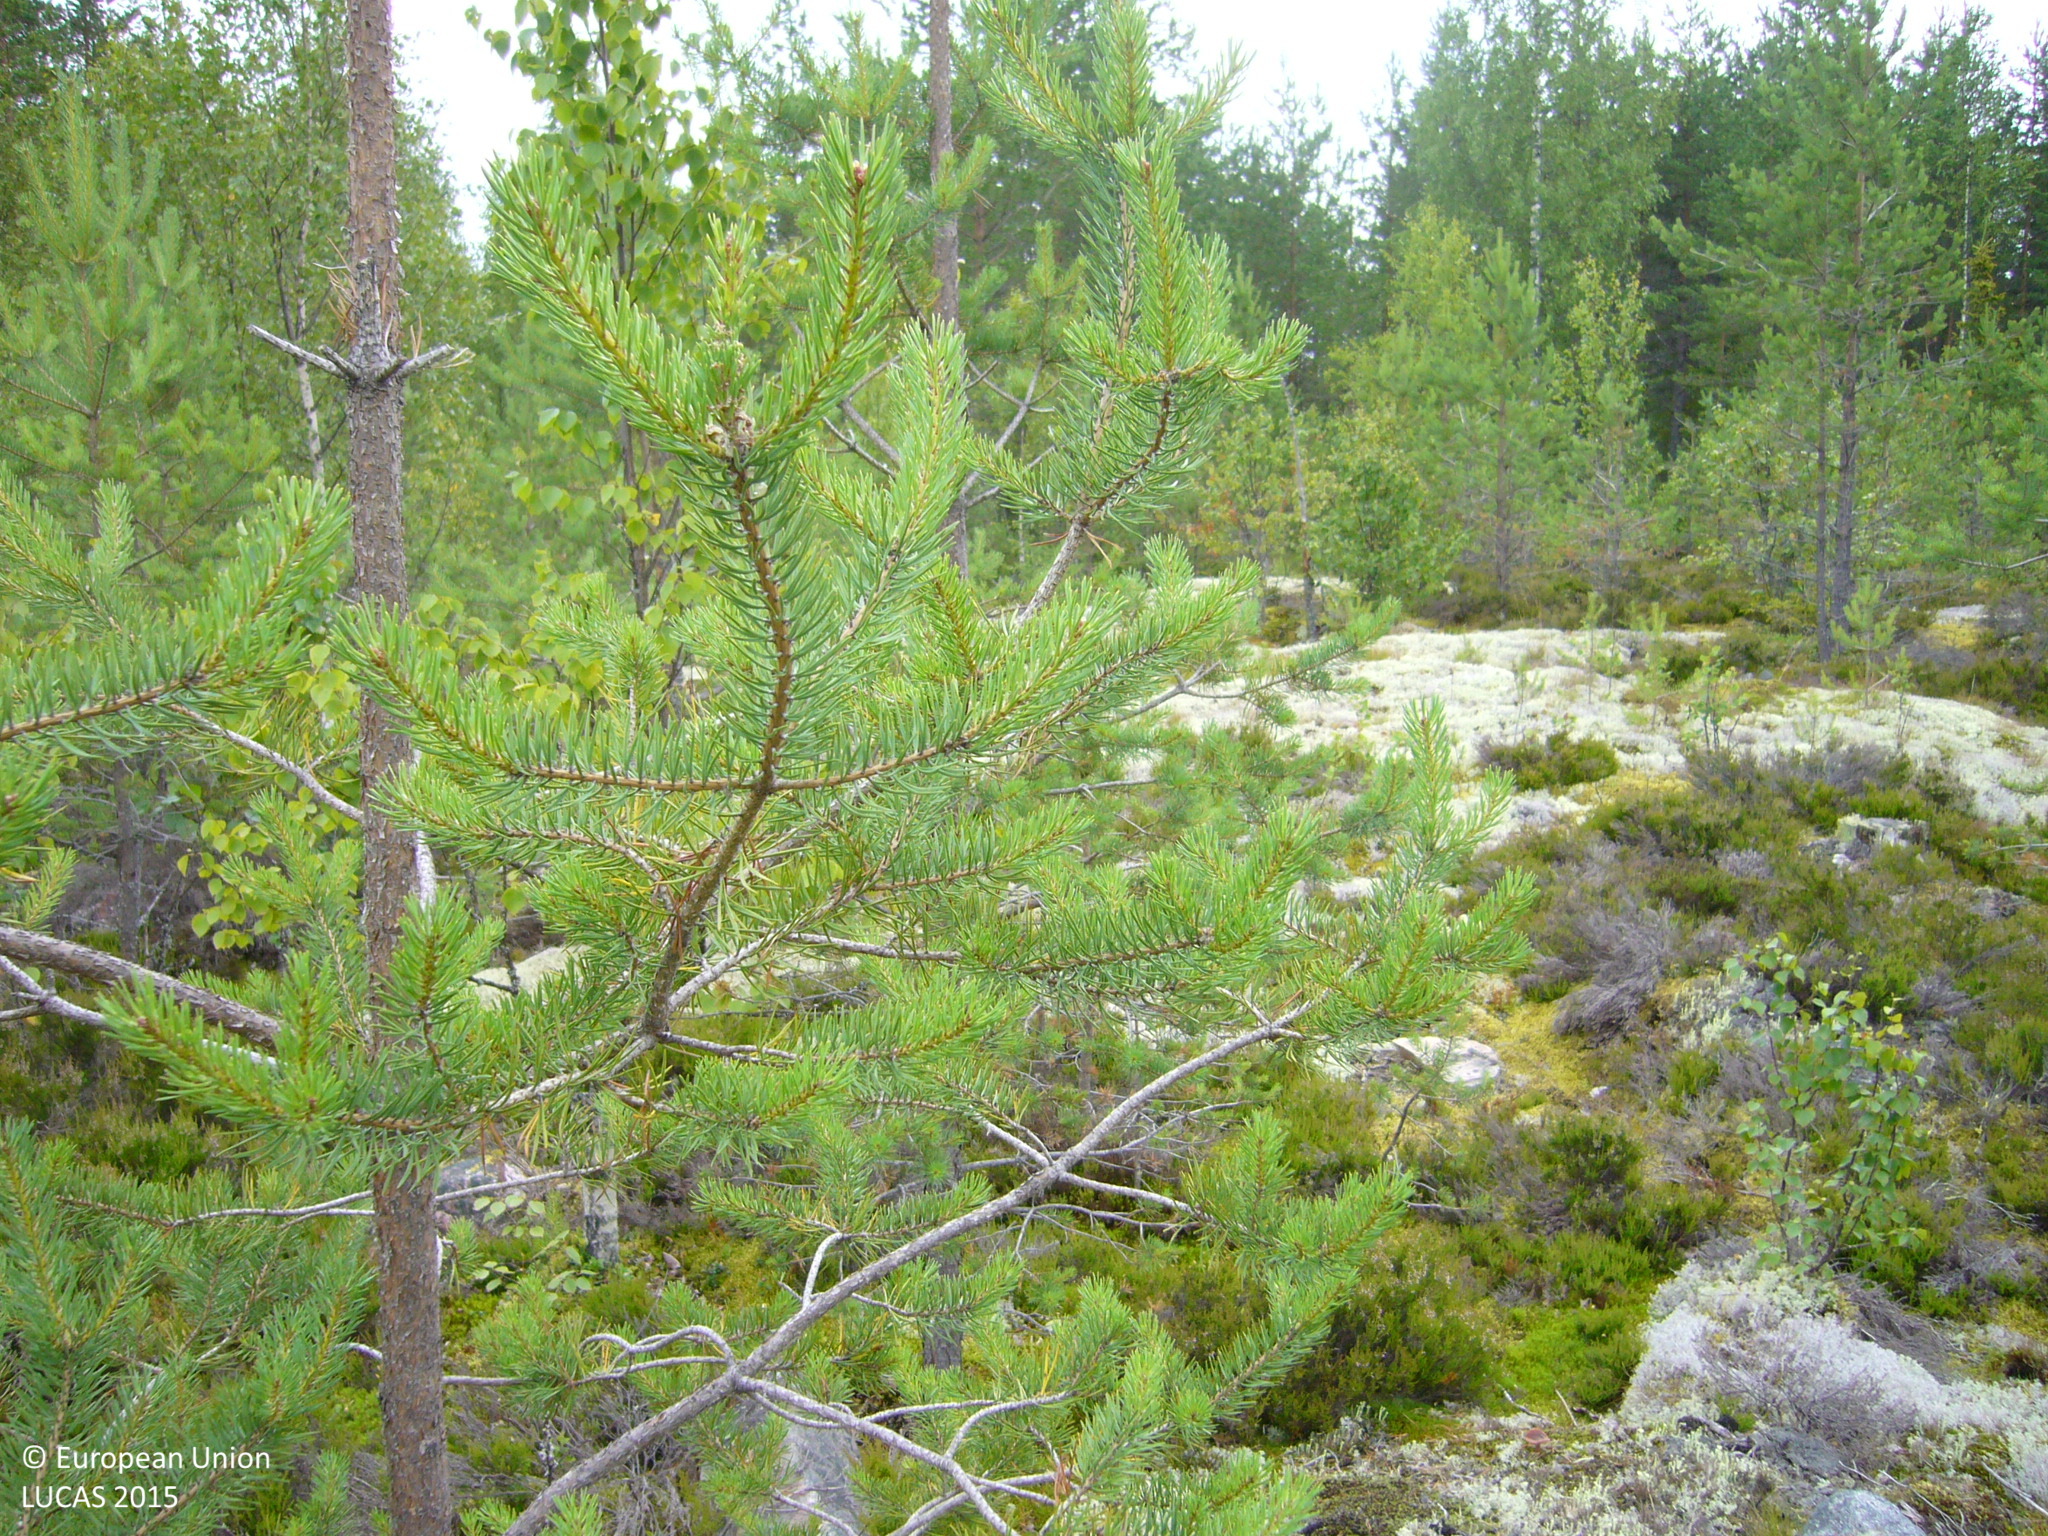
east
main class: Woodland
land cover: Pine dominated mixed woodland
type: boreal forest
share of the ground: 50 - 75 %
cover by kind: coniferous forest trees 30 %, lichens and mosses 30 %, broadleaved forest trees 20 %, consolidated bare surface 20 %
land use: Forestry
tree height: < 5 m
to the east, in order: Pine dominated mixed woodland; Ditches and canals; Pine dominated mixed woodland; Other mixed woodland; Ditches and canals; Other mixed woodland; Pine dominated mixed woodland; Ditches and canals; Pine dominated mixed woodland
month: July
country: FI
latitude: 63.9447
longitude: 26.2139
